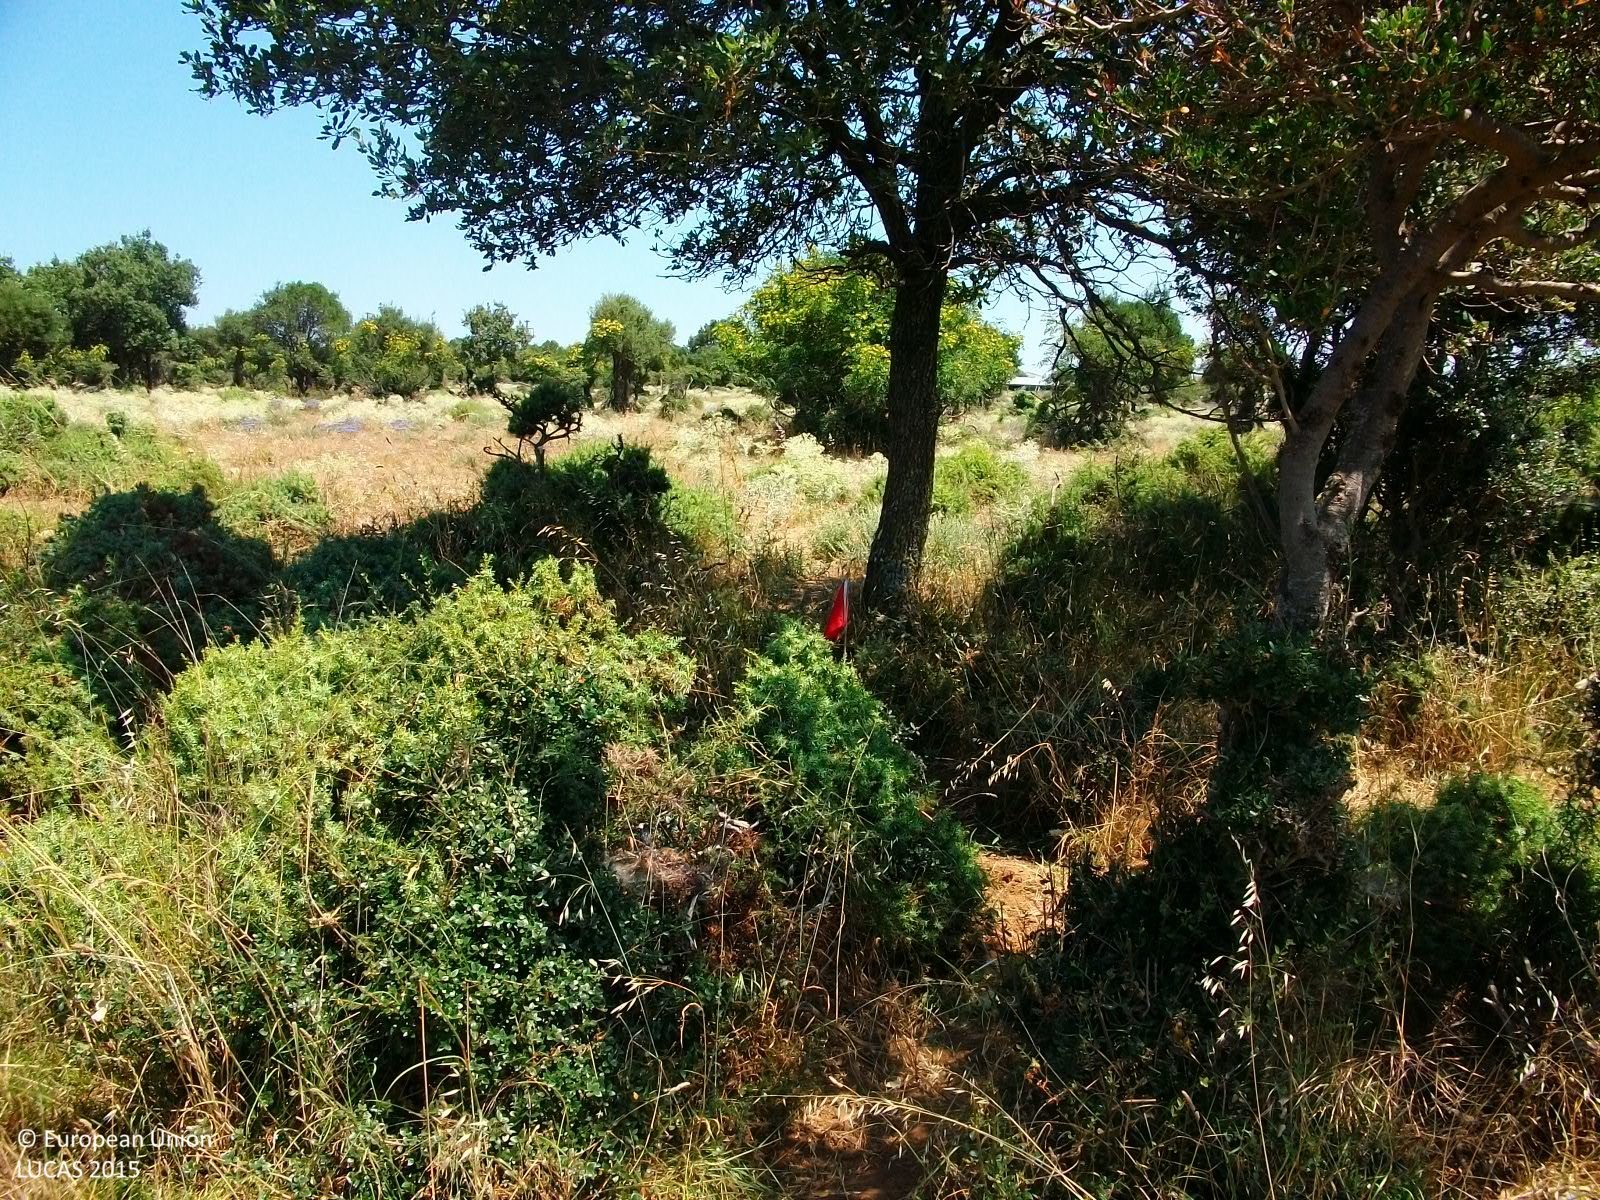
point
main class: Woodland
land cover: Broadleaved woodland
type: thermophilous deciduous forest
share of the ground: 50 - 75 %
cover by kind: broadleaved forest trees 50 %, herbaceous plants 25 %, shrubs 15 %, unconsolidated bare surface 10 %
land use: Semi-natural and natural areas not in use
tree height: > 5 m
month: July
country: GR
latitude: 40.8892
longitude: 26.1442
